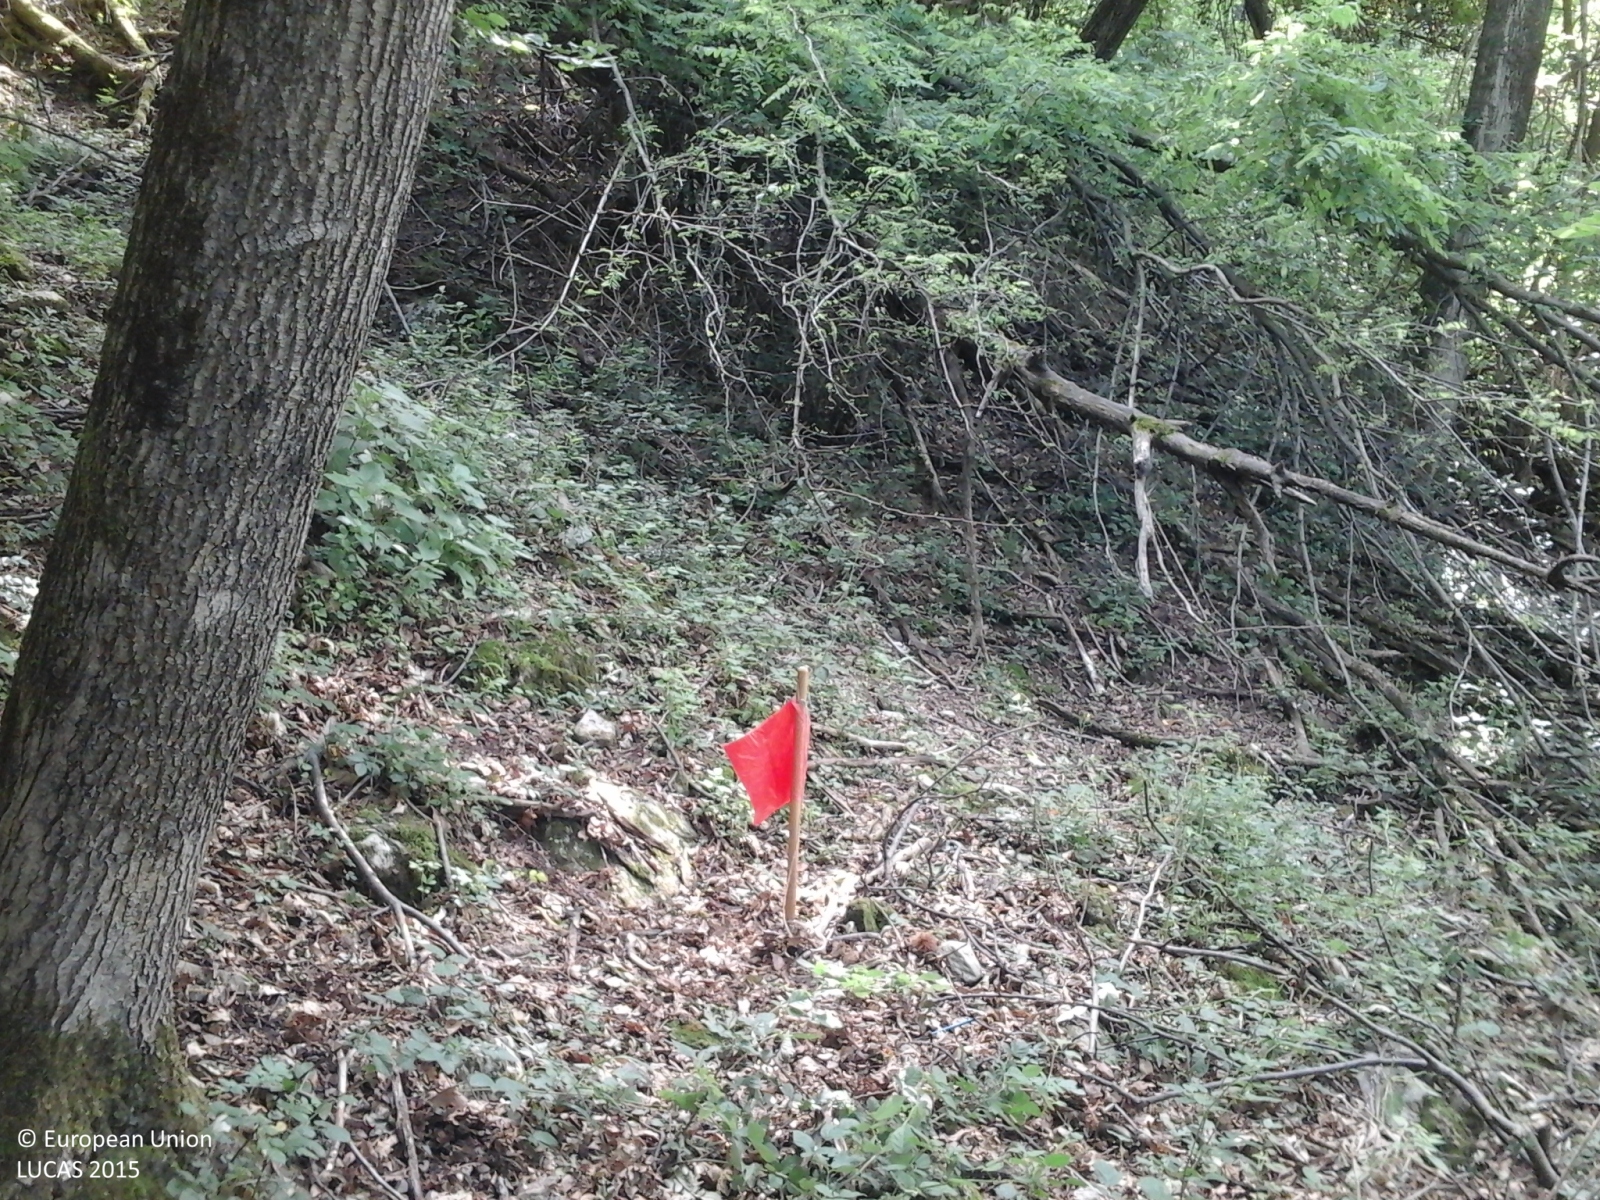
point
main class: Woodland
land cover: Broadleaved woodland
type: thermophilous deciduous forest
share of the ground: > 75 %
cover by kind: broadleaved forest trees 100 %
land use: Semi-natural and natural areas not in use
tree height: > 5 m
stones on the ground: > 50 %
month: June
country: IT
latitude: 45.9112
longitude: 8.7256
